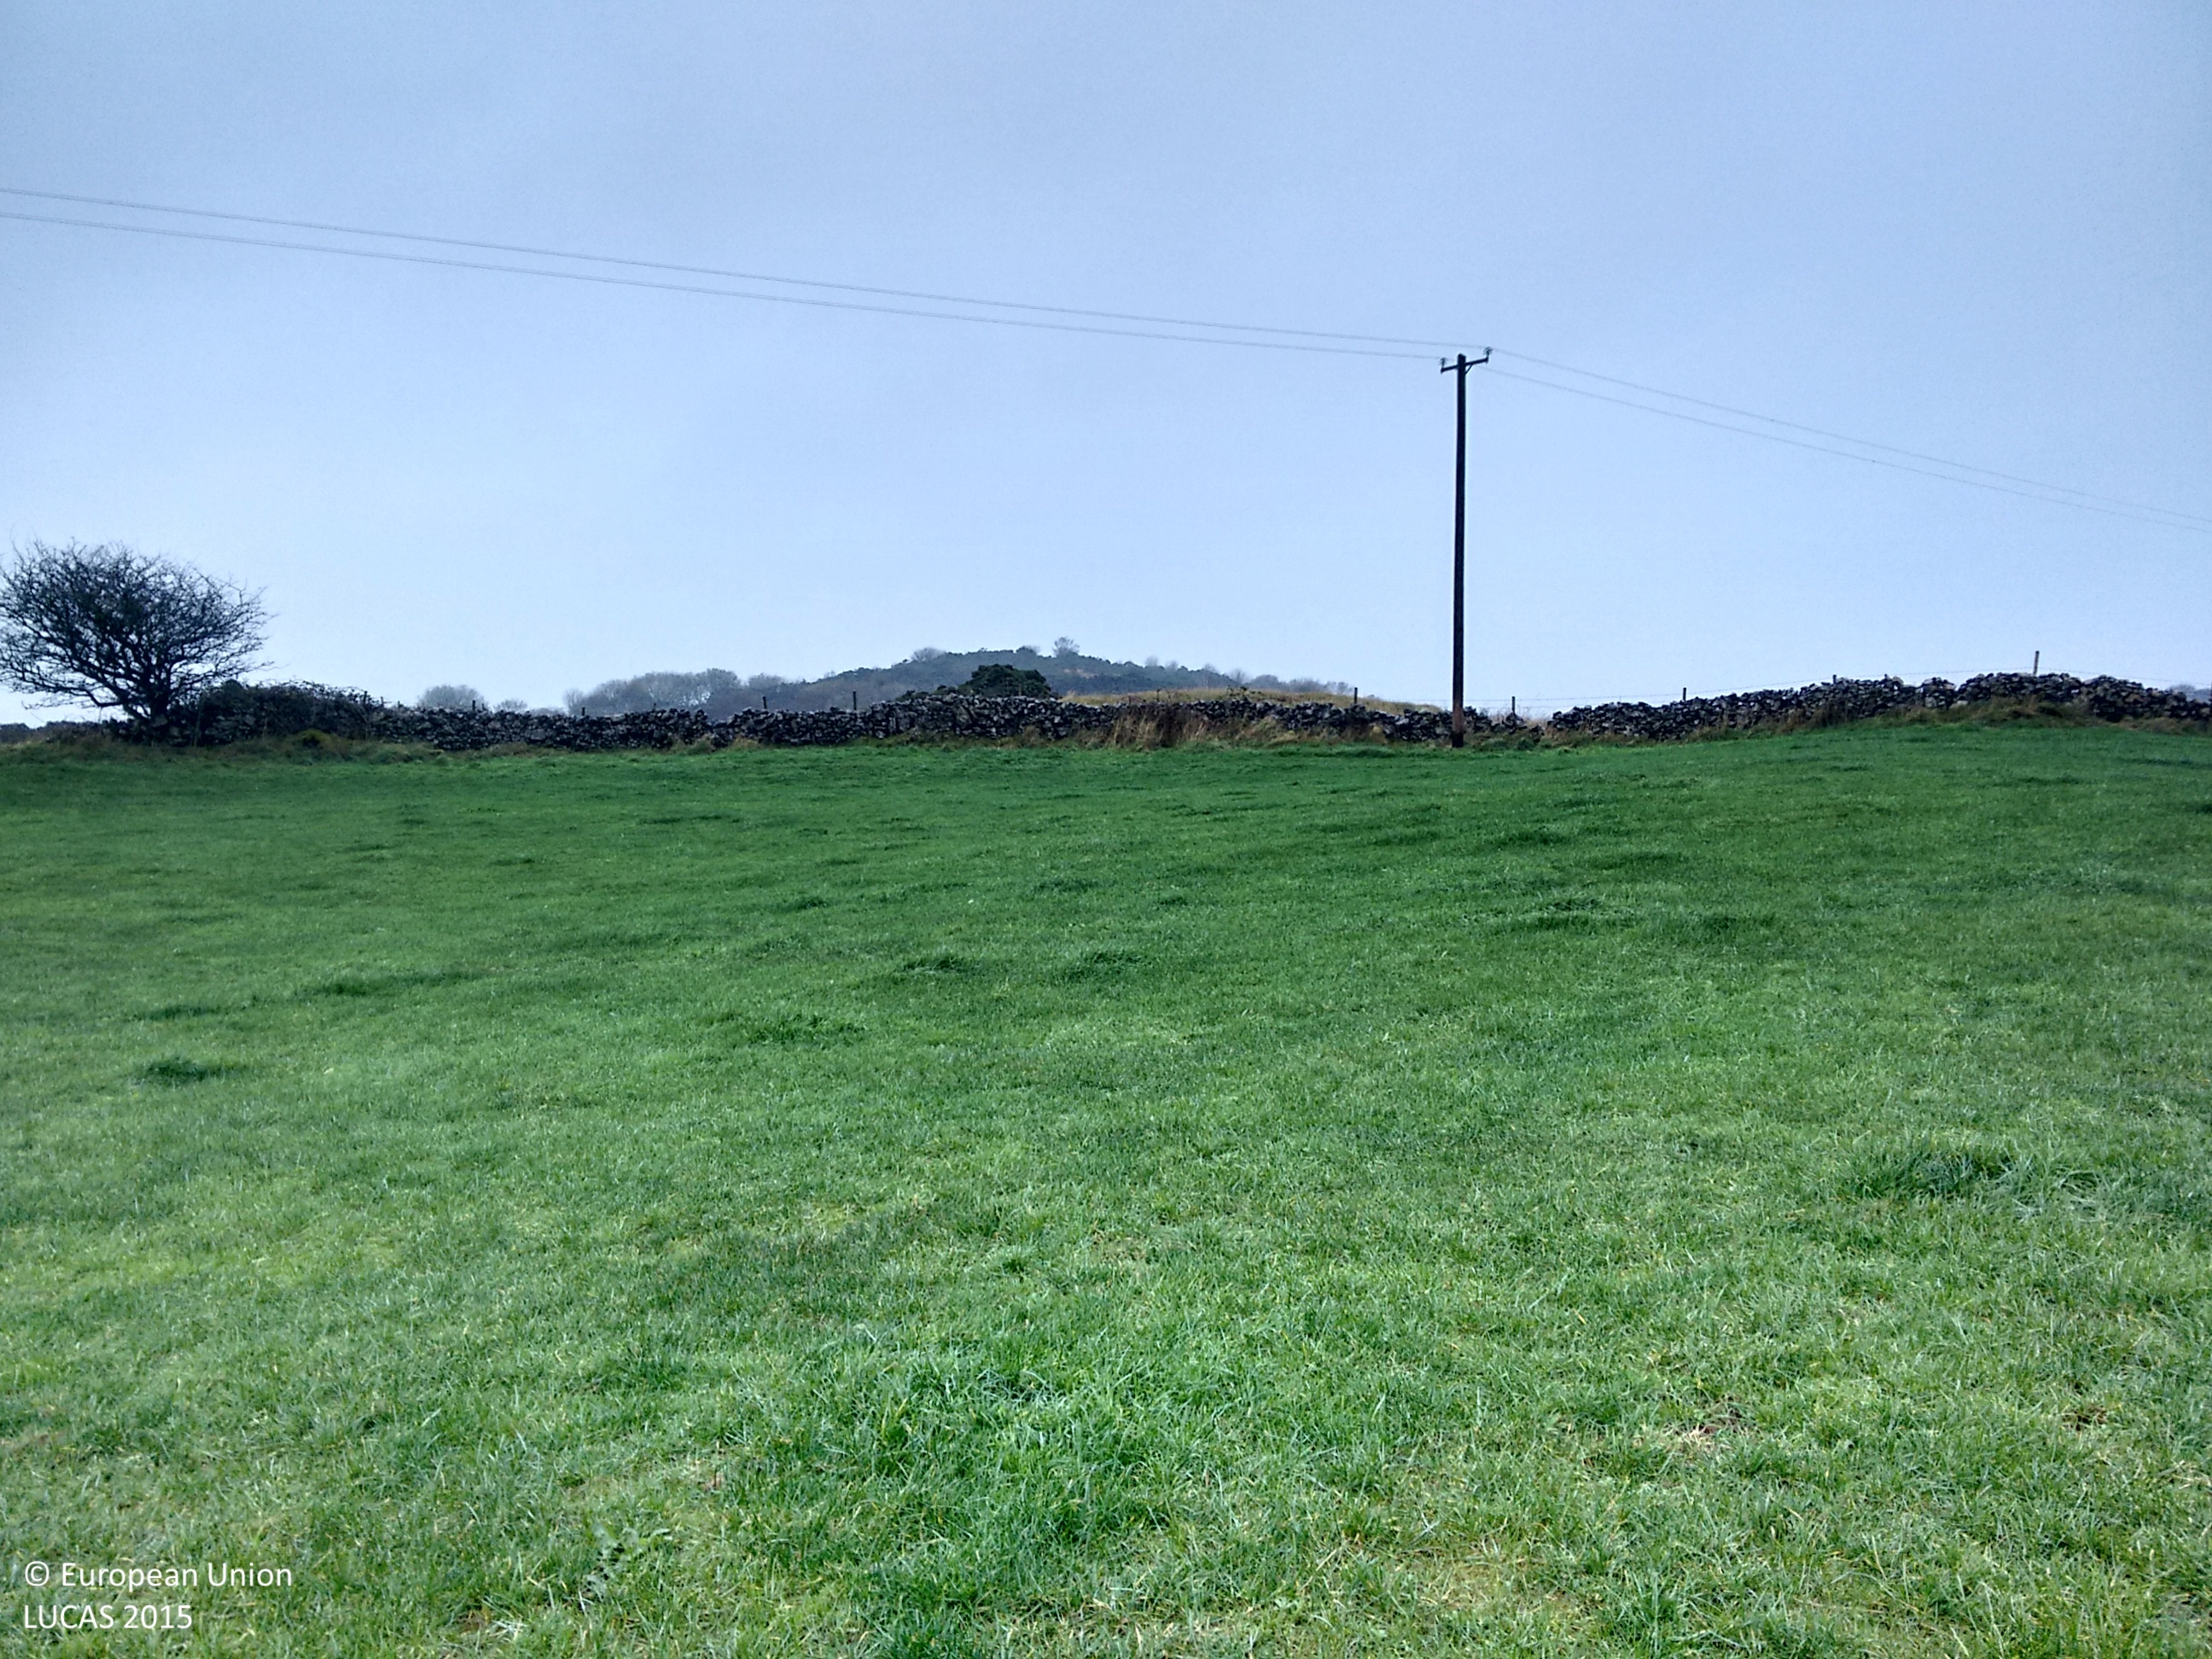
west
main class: Grassland
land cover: Grassland without tree/shrub cover
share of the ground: > 75 %
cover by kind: herbaceous plants 100 %
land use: Agriculture (excluding fallow land and kitchen gardens)
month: November
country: IE
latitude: 54.5341
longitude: -8.0875
